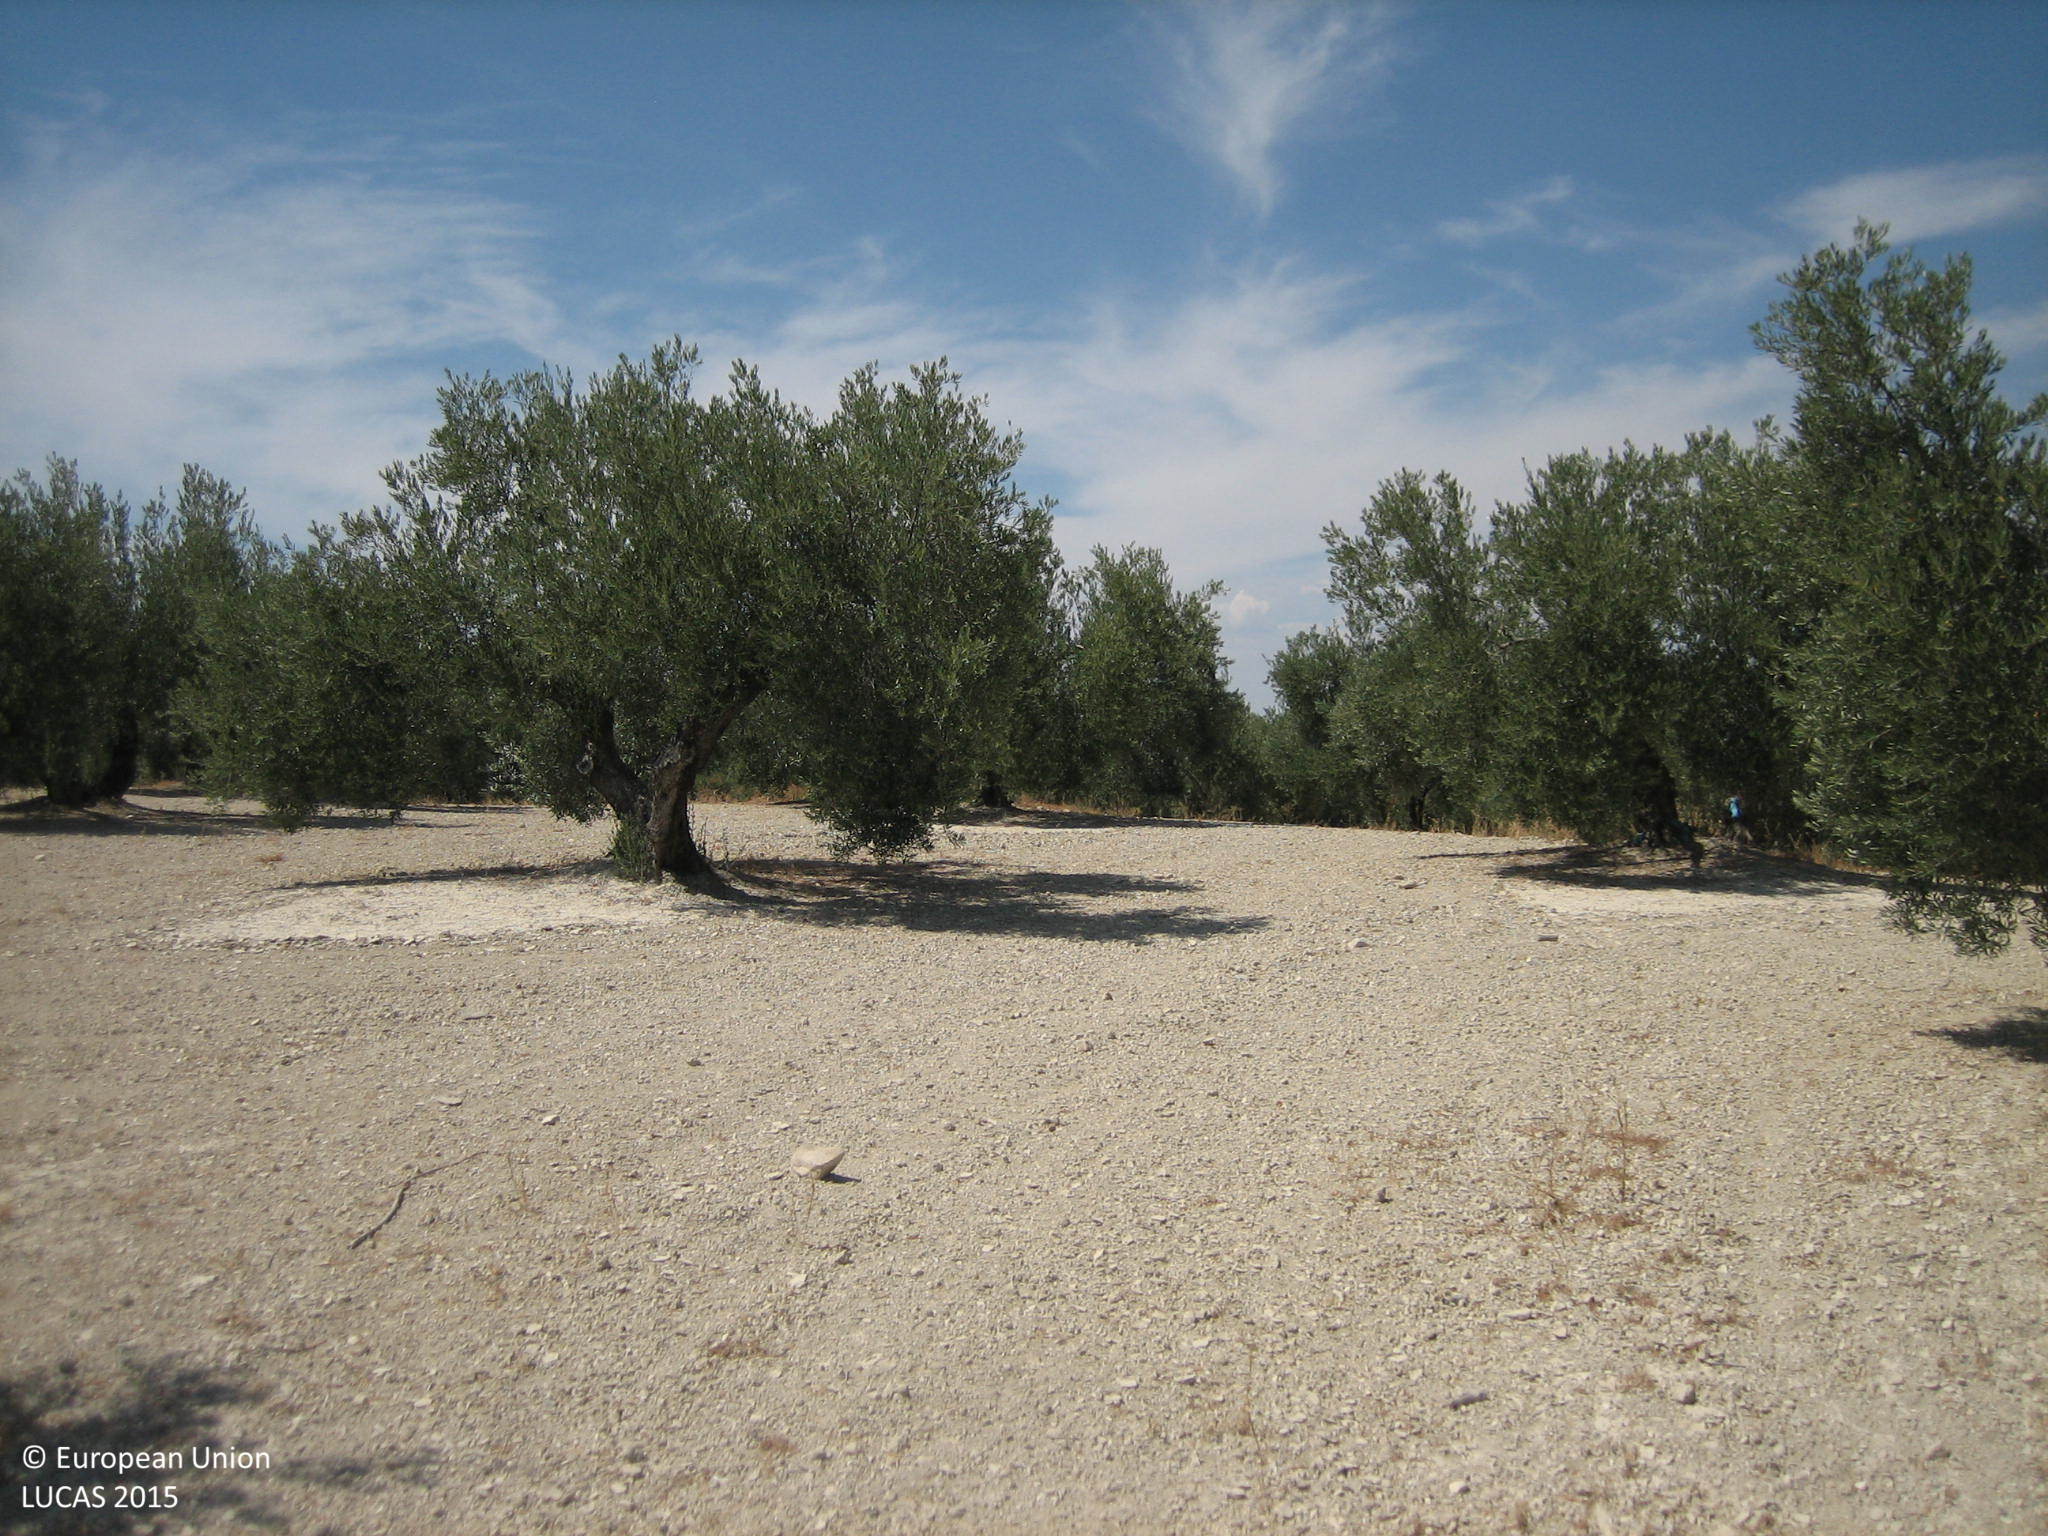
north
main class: Cropland
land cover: Olive groves
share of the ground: 10 - 25 %
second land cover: Other bare soil
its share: > 75 %
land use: Agriculture (excluding fallow land and kitchen gardens)
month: June
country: ES
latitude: 37.8579
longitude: -3.7890
